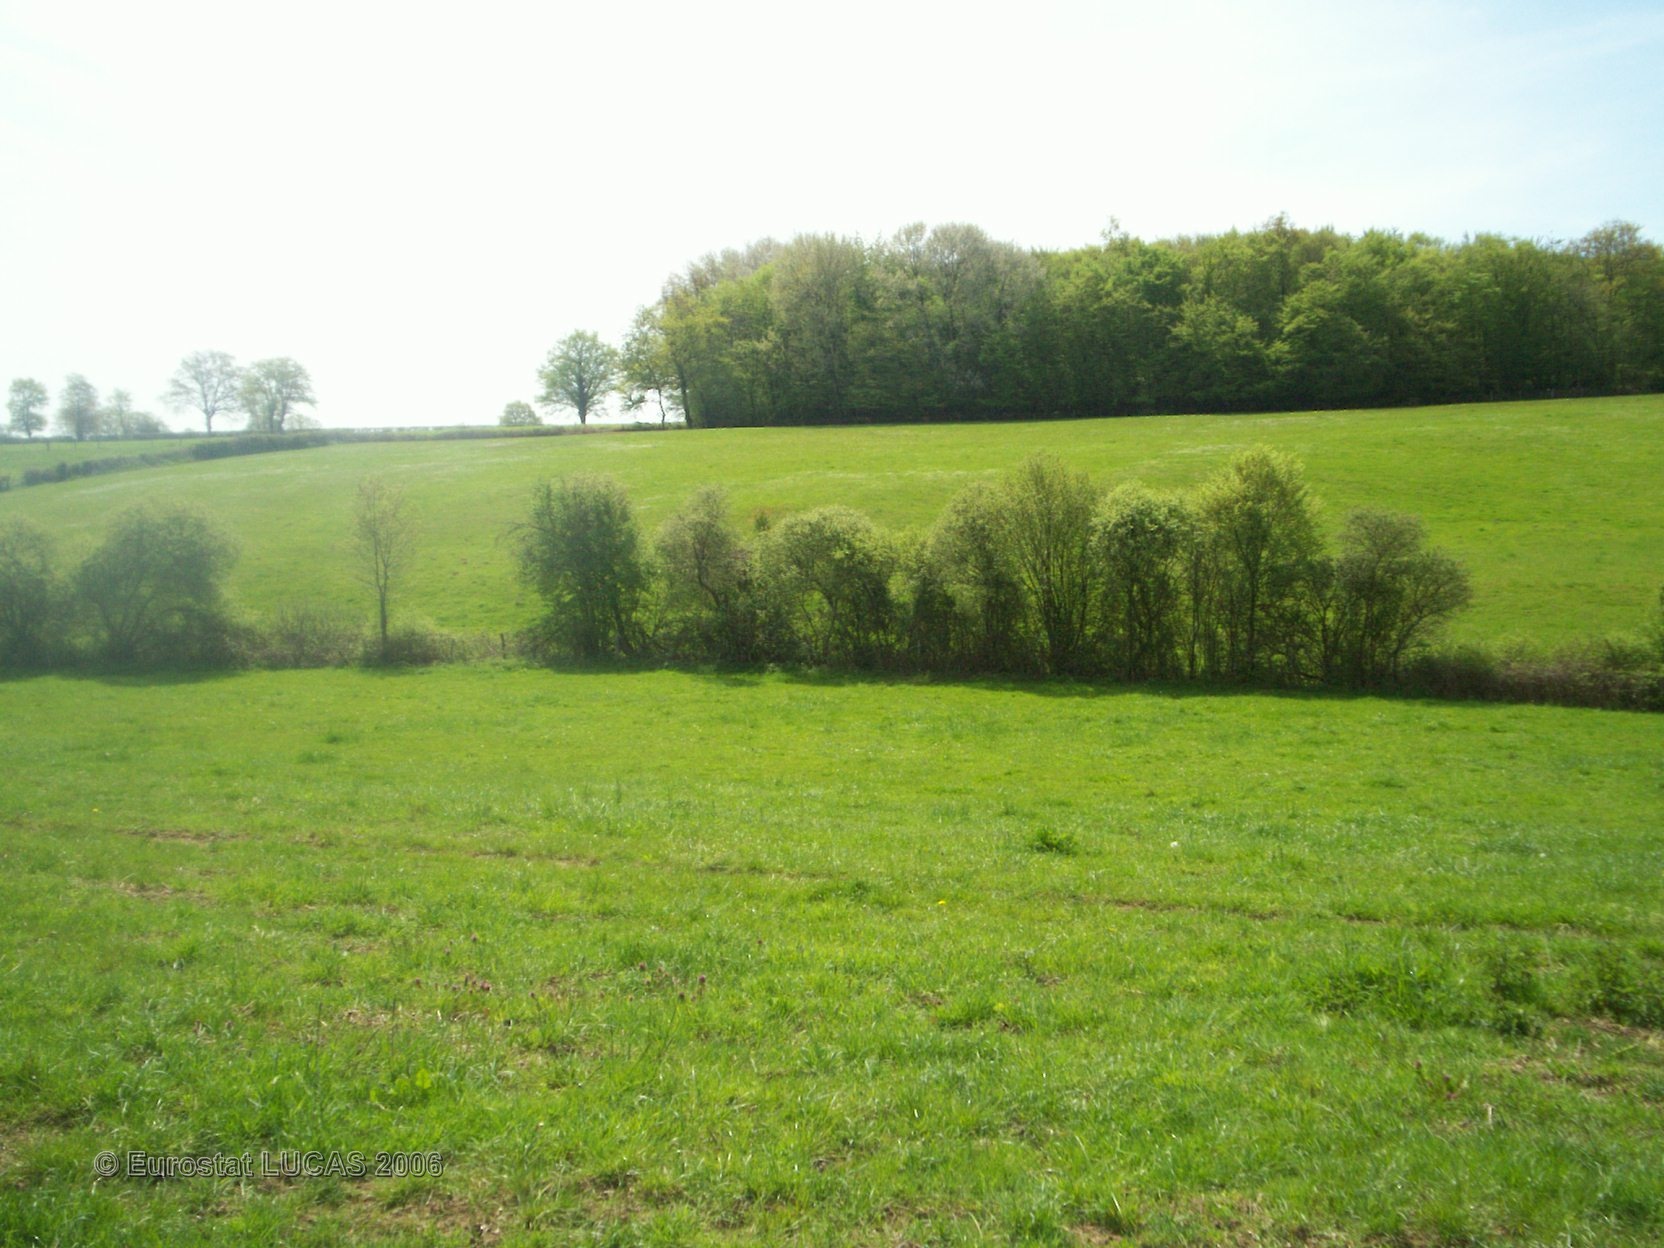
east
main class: Grassland
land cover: Grassland without tree/shrub cover
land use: Agriculture (excluding fallow land and kitchen gardens)
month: May
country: FR
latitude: 46.3826
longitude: 3.1197
